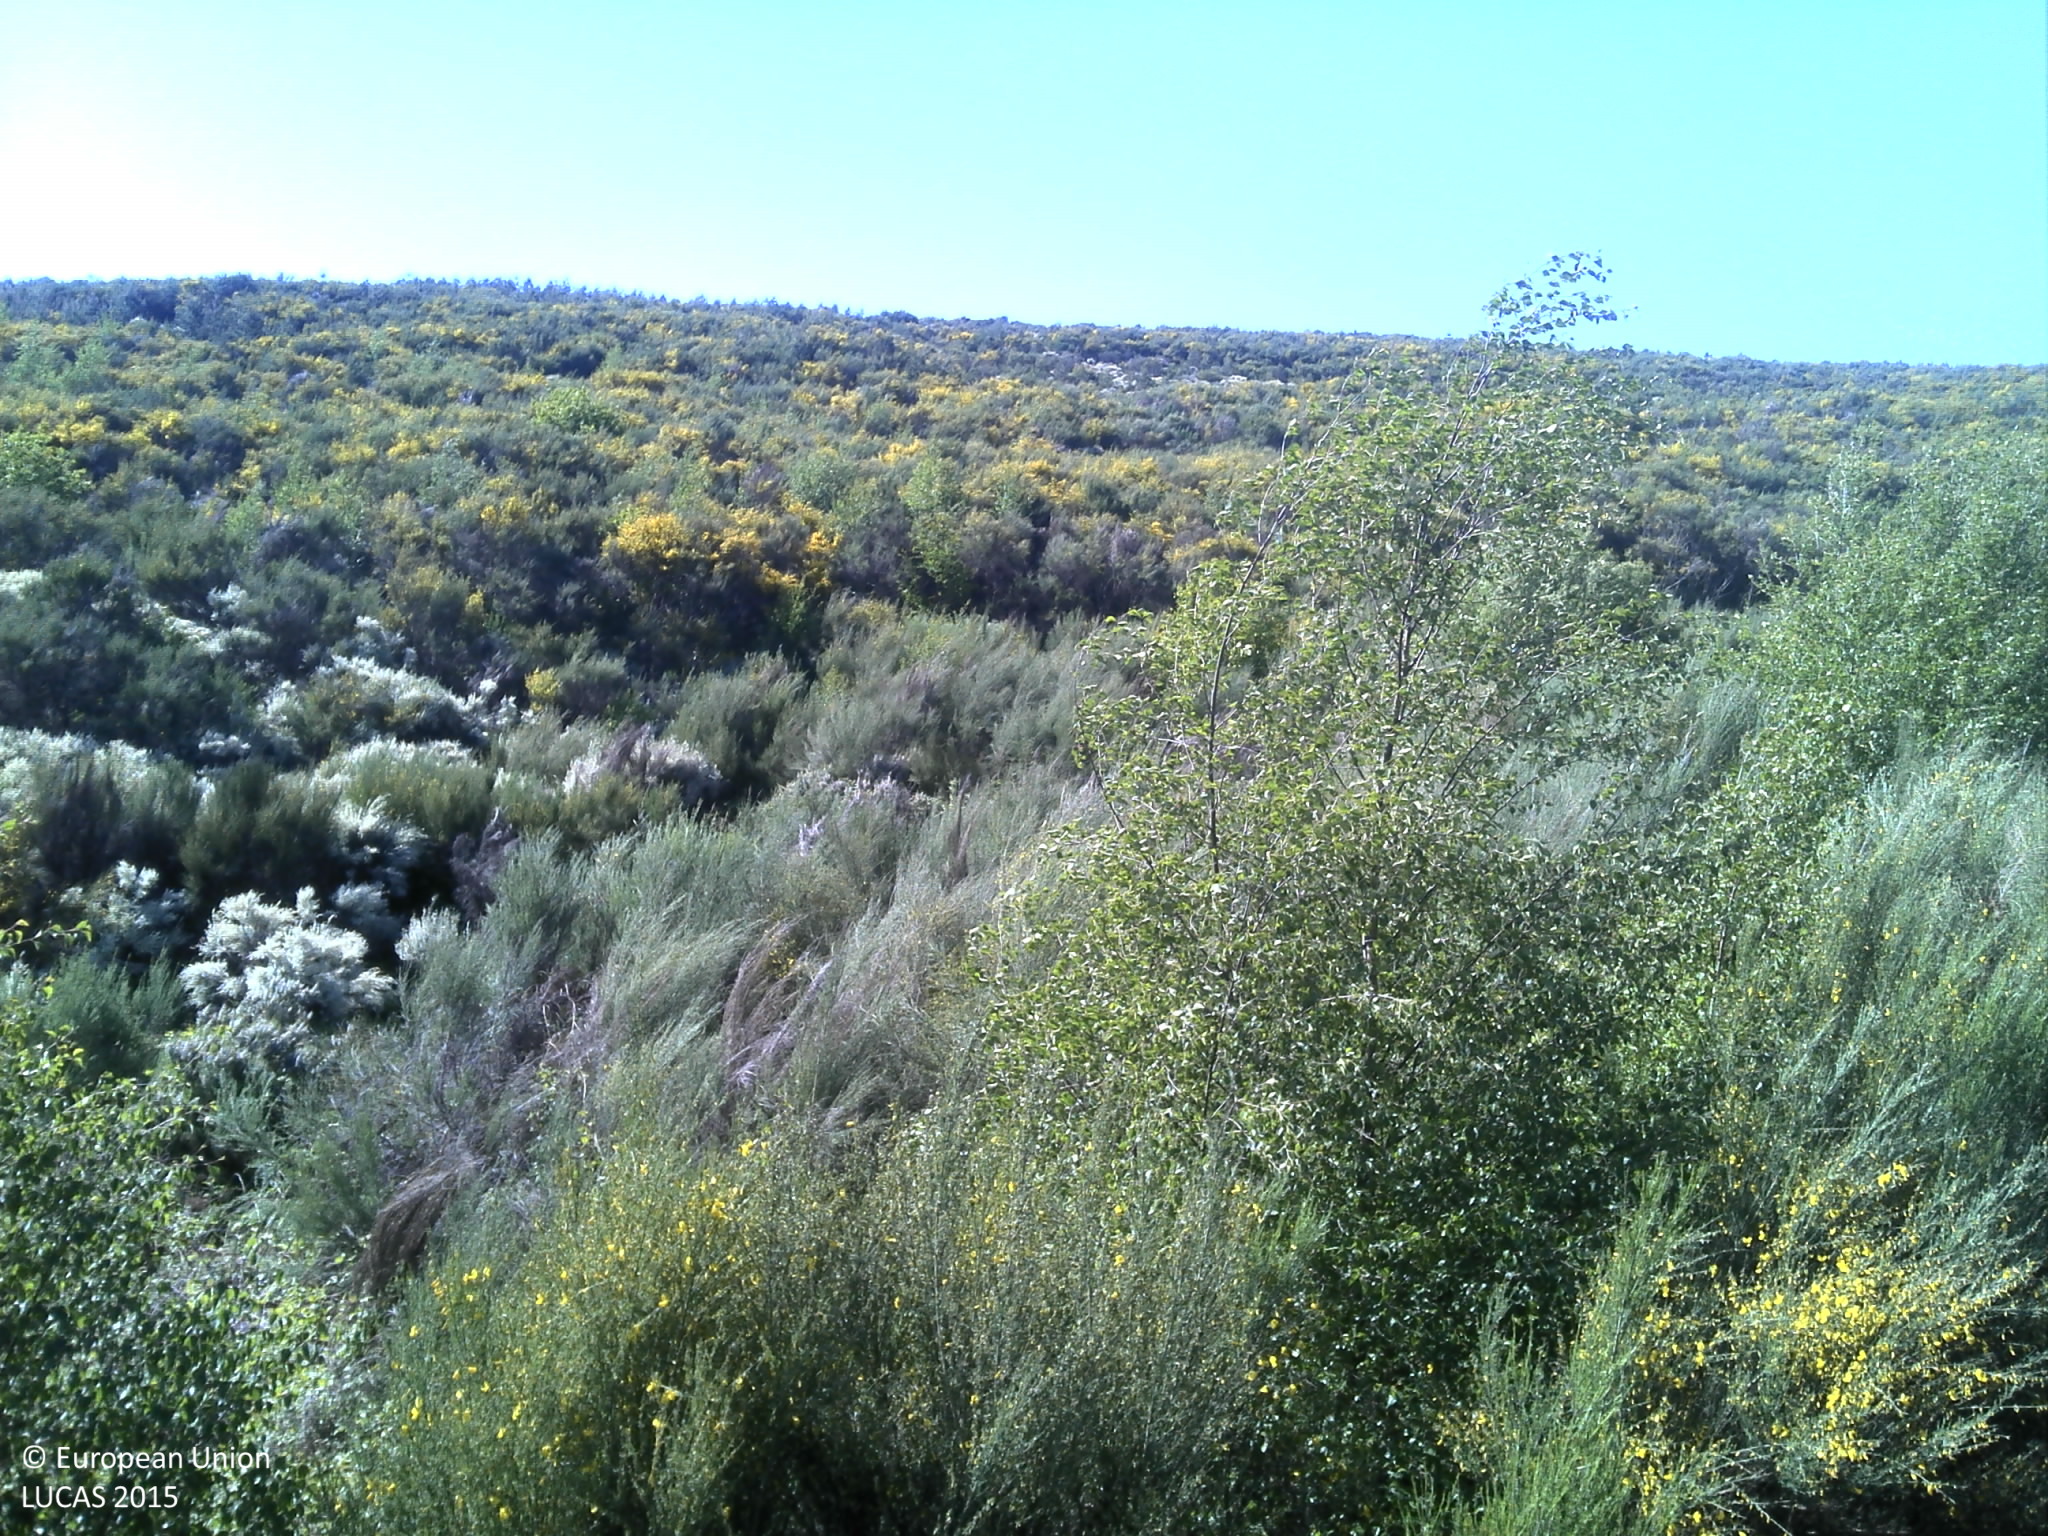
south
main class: Shrubland
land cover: Shrubland without tree cover
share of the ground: > 75 %
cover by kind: shrubs 75 %, herbaceous plants 15 %, unconsolidated bare surface 10 %
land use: Semi-natural and natural areas not in use
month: May
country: PT
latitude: 40.5429
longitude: -7.4071
